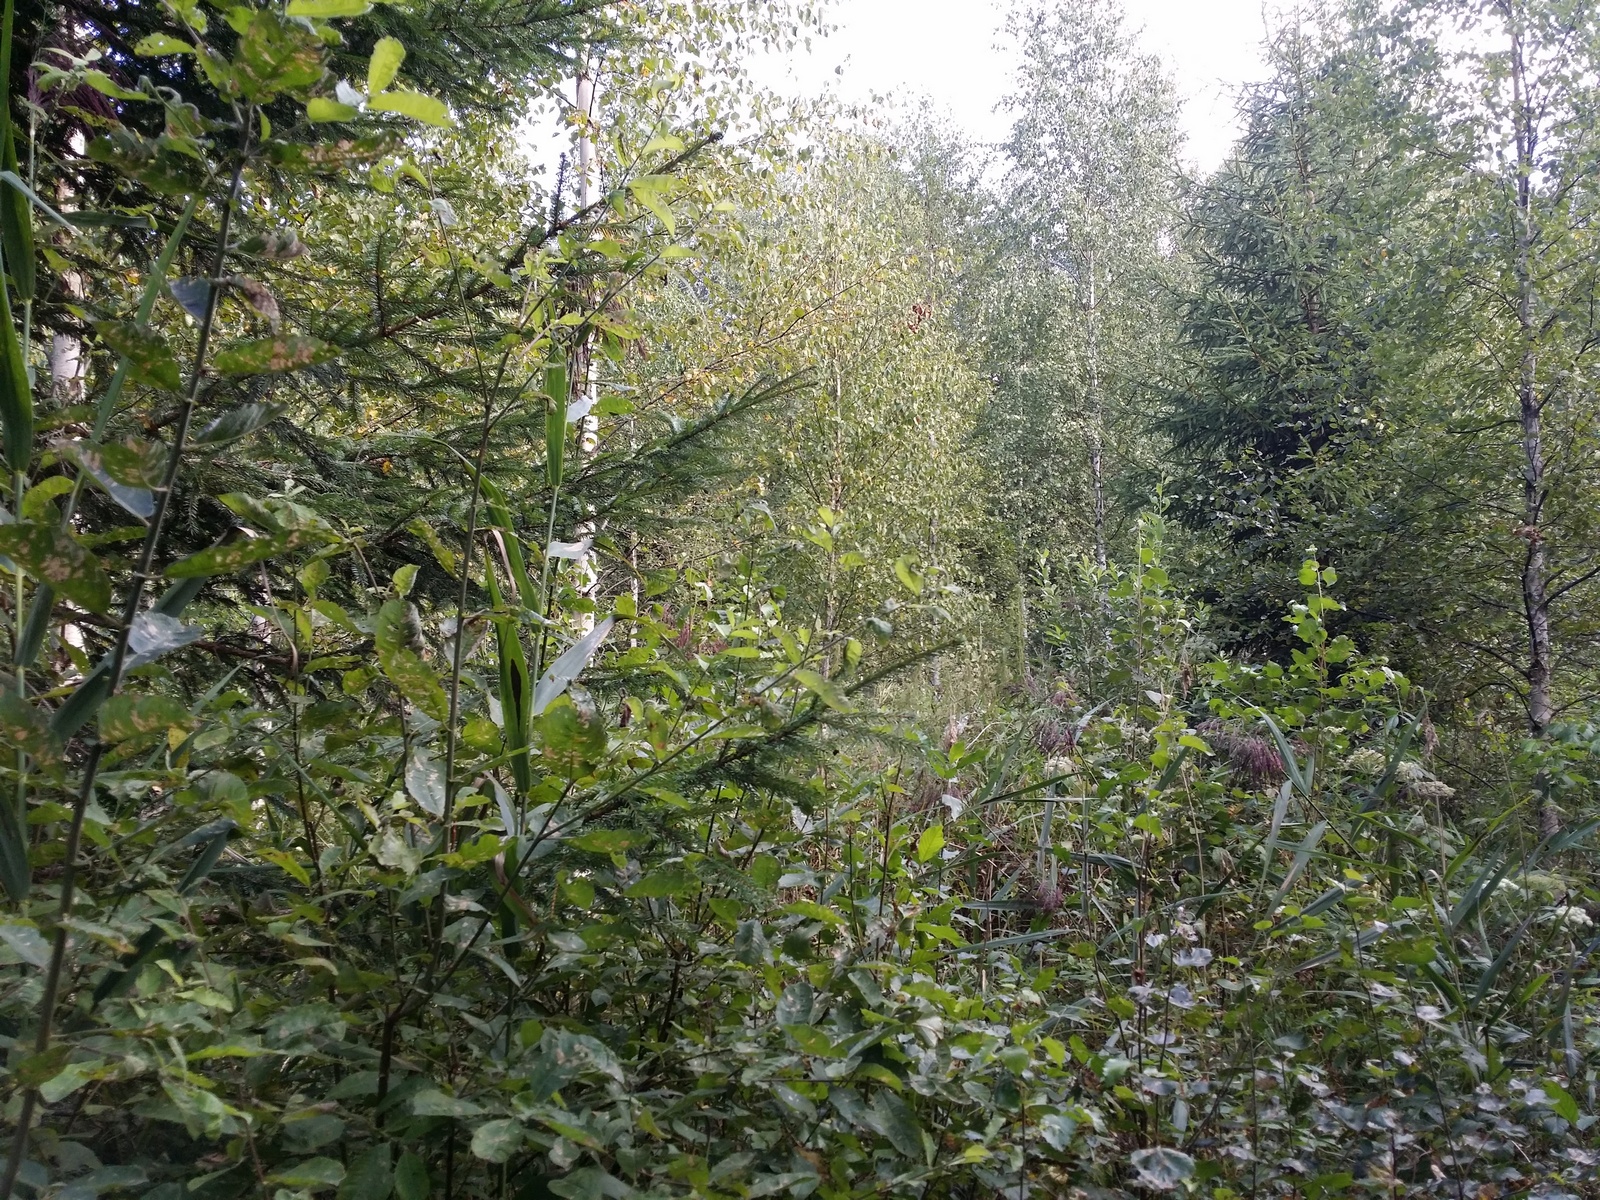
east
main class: Woodland
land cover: Broadleaved woodland
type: non-riverine alder, birch or aspen forest
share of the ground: > 75 %
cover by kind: broadleaved forest trees 75 %, shrubs 15 %, coniferous forest trees 10 %
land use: Forestry
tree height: > 5 m
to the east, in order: Broadleaved woodland; Ditches and canals; Grassland with sparse tree/shrub cover; Broadleaved woodland; Other mixed woodland; Abandoned hedges; Ditches and canals; Broadleaved woodland; Ditches and canals; Broadleaved woodland; Shrubland with sparse tree cover
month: August
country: LV
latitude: 57.2989
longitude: 27.6216
